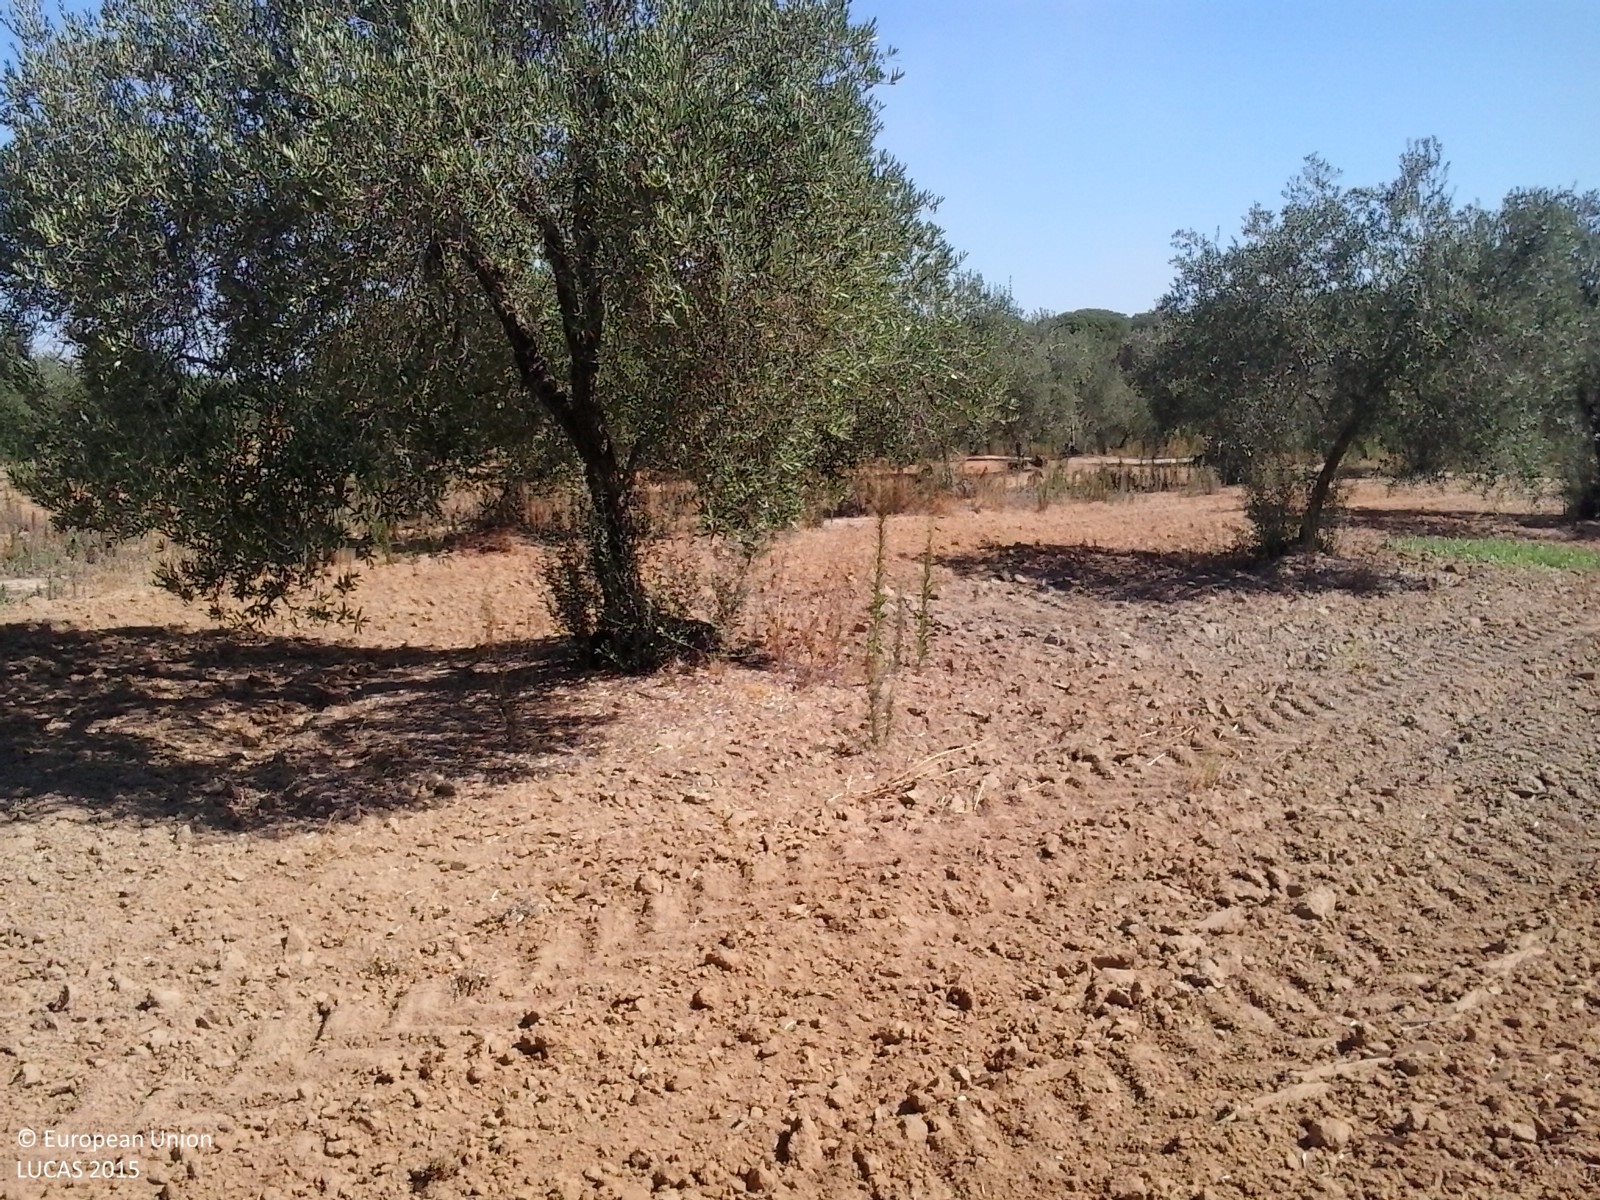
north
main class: Cropland
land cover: Olive groves
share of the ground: 10 - 25 %
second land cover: Other bare soil
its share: > 75 %
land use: Agriculture (excluding fallow land and kitchen gardens)
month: July
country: ES
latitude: 37.2604
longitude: -6.3659
